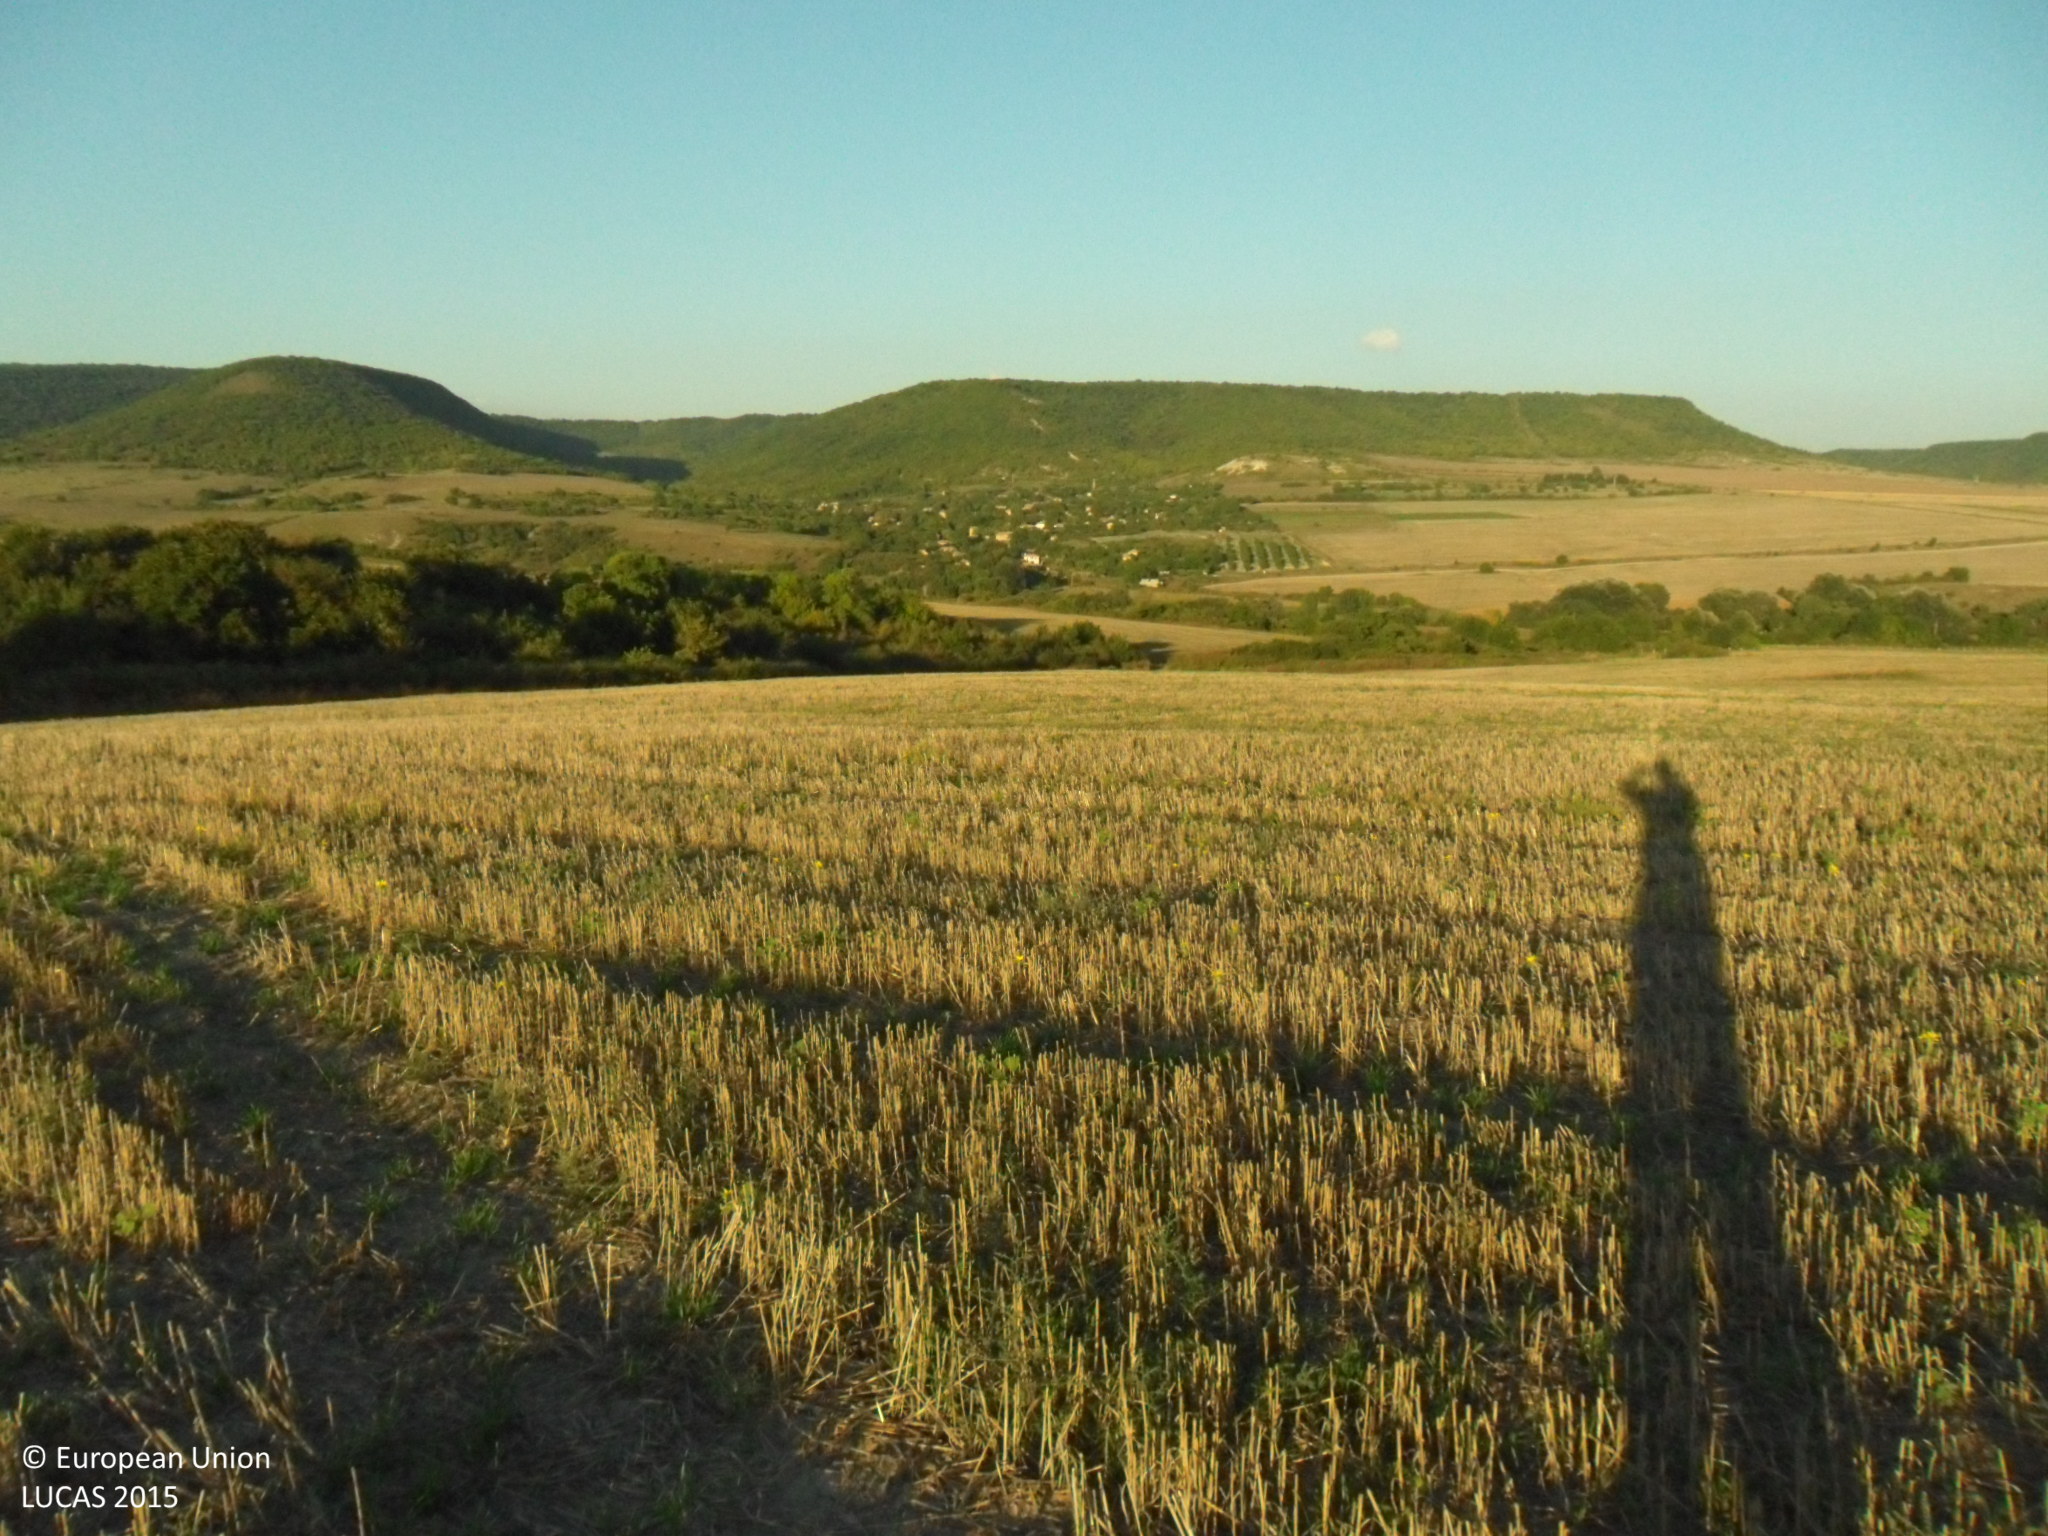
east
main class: Cropland
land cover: Common wheat
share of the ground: > 75 %
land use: Agriculture (excluding fallow land and kitchen gardens)
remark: Harvested field
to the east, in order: Common wheat
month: September
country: BG
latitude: 43.4245
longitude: 27.1541
